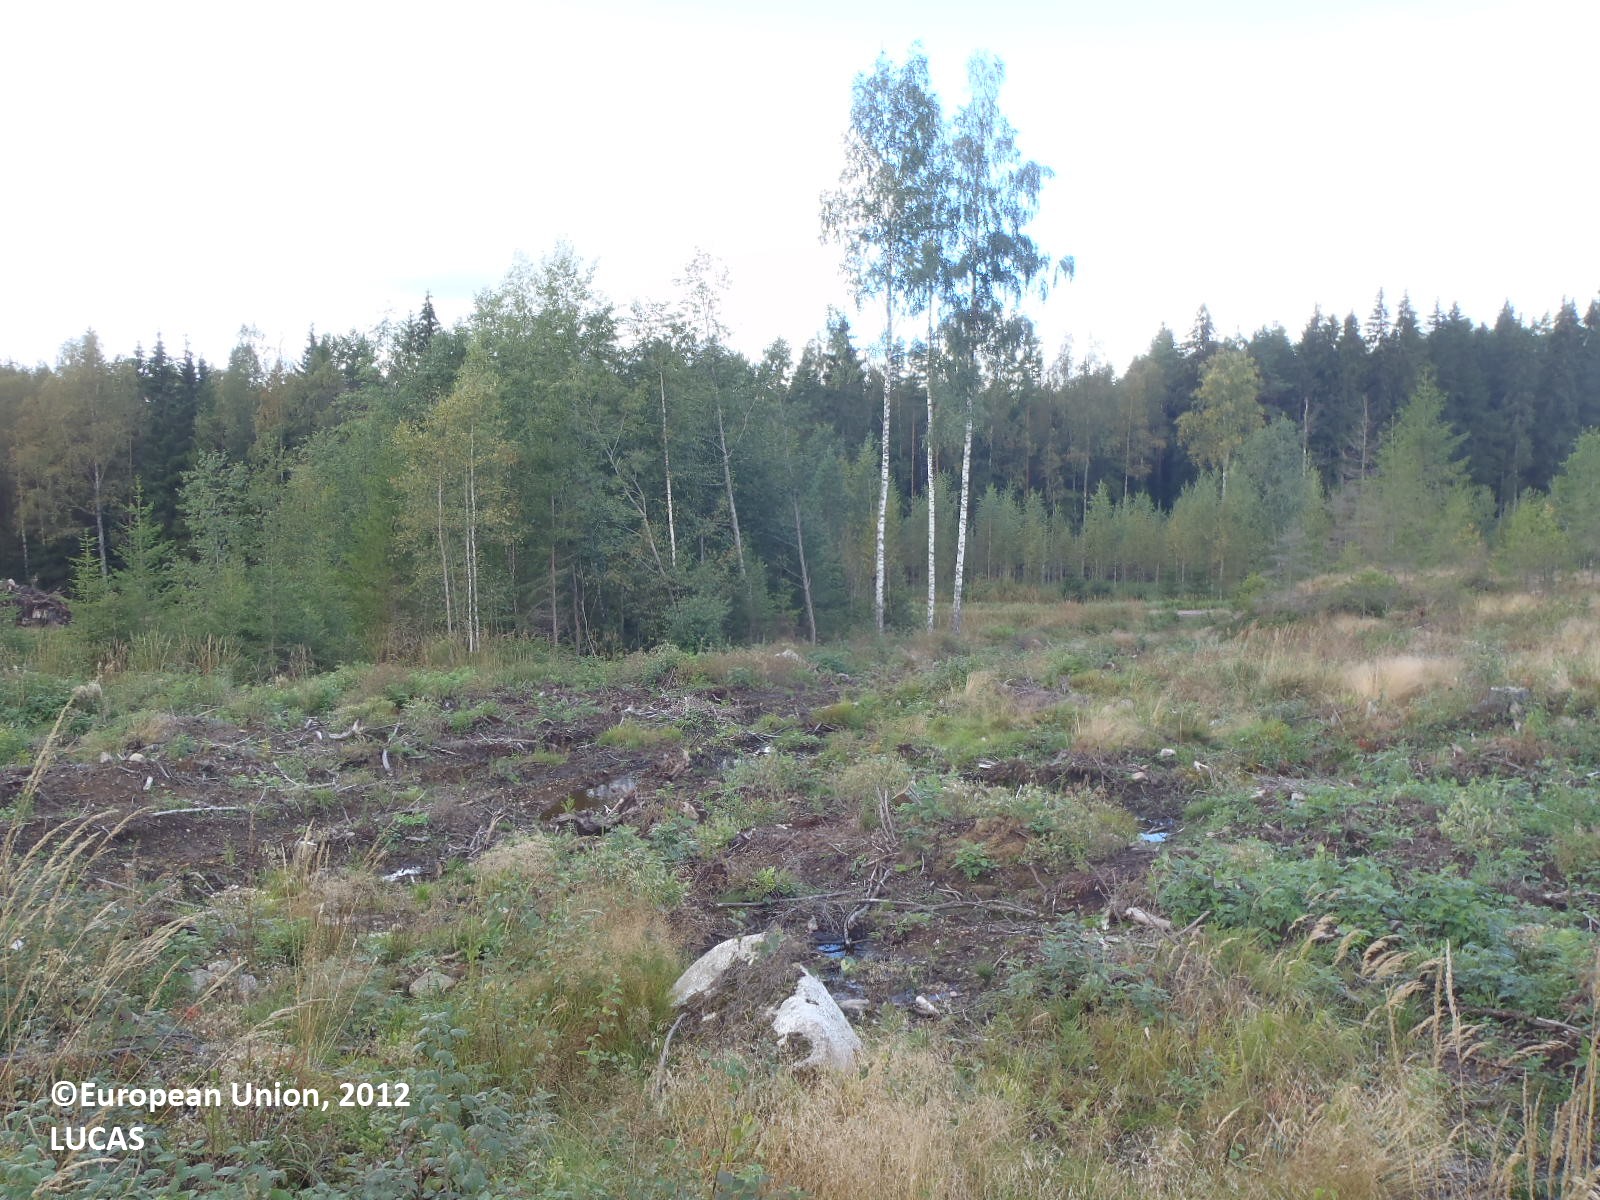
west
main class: Shrubland
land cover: Shrubland with sparse tree cover
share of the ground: > 75 %
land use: Forestry
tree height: > 5 m
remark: Clear cut
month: September
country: FI
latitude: 61.2917
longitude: 22.6264
